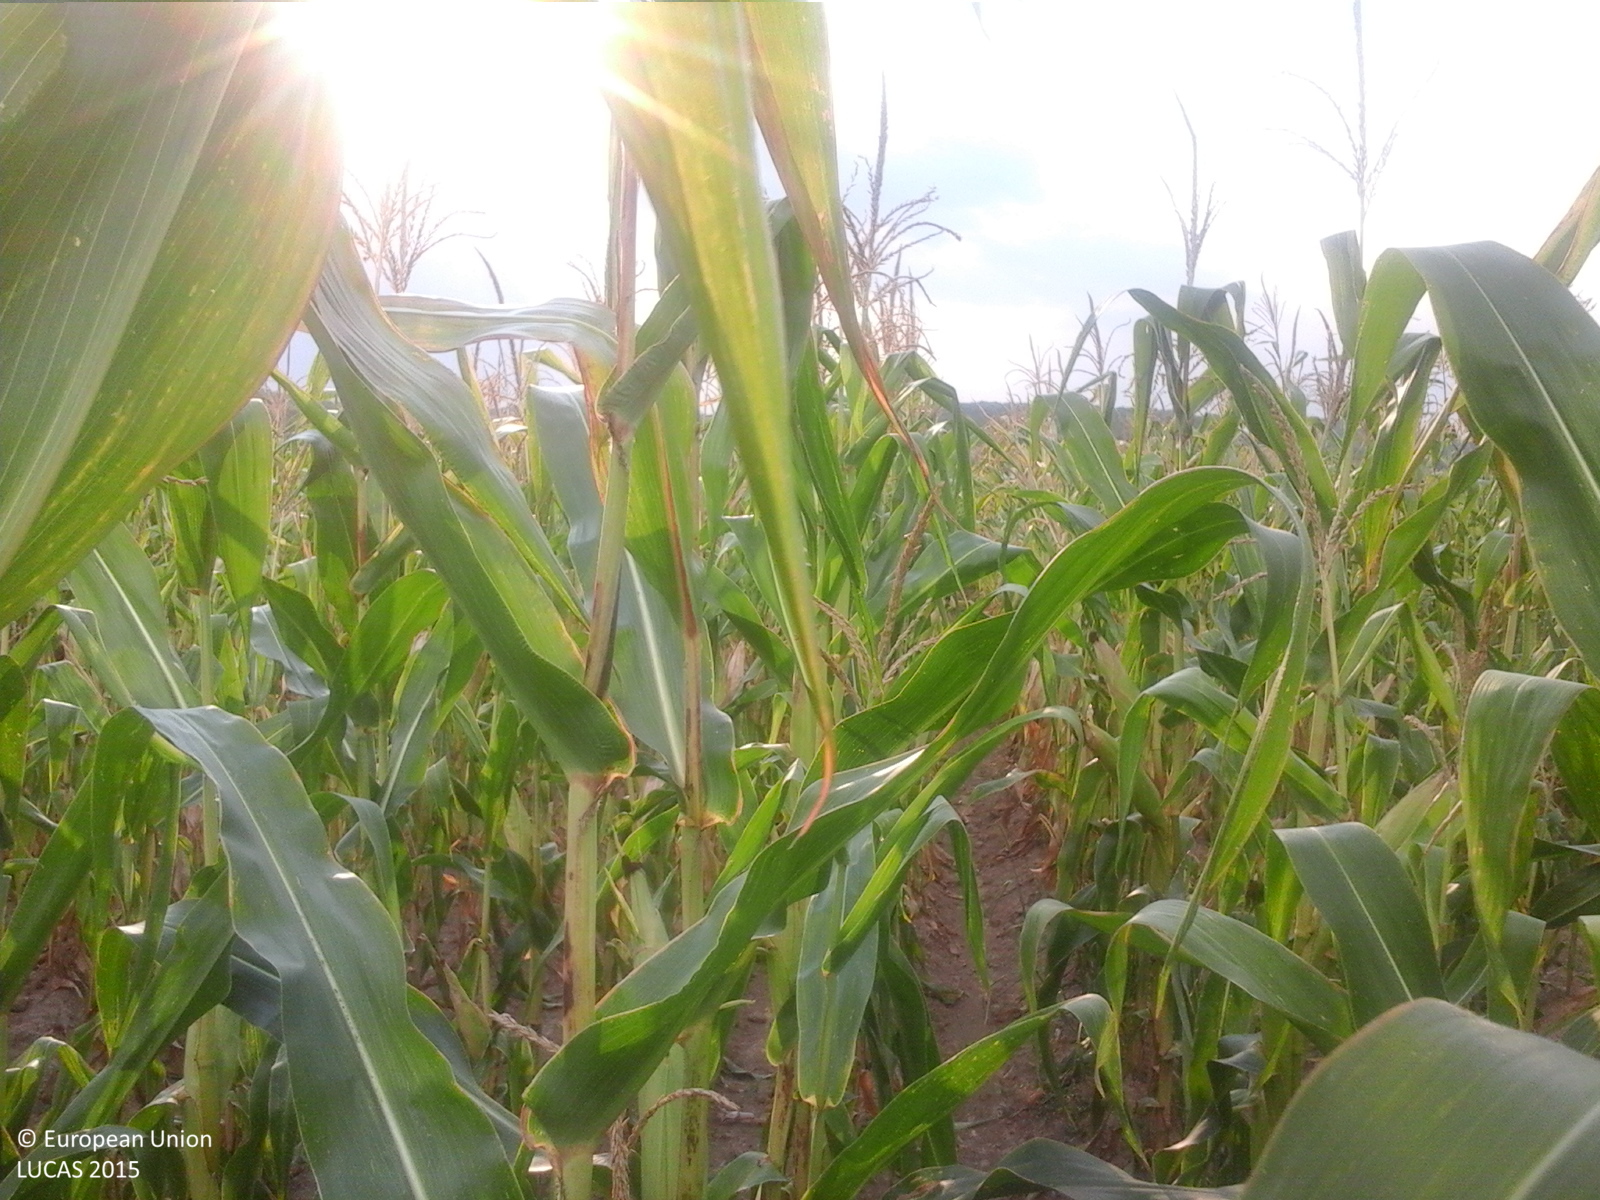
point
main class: Cropland
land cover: Maize
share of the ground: > 75 %
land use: Agriculture (excluding fallow land and kitchen gardens)
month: August
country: RO
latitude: 44.7606
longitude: 23.6386
